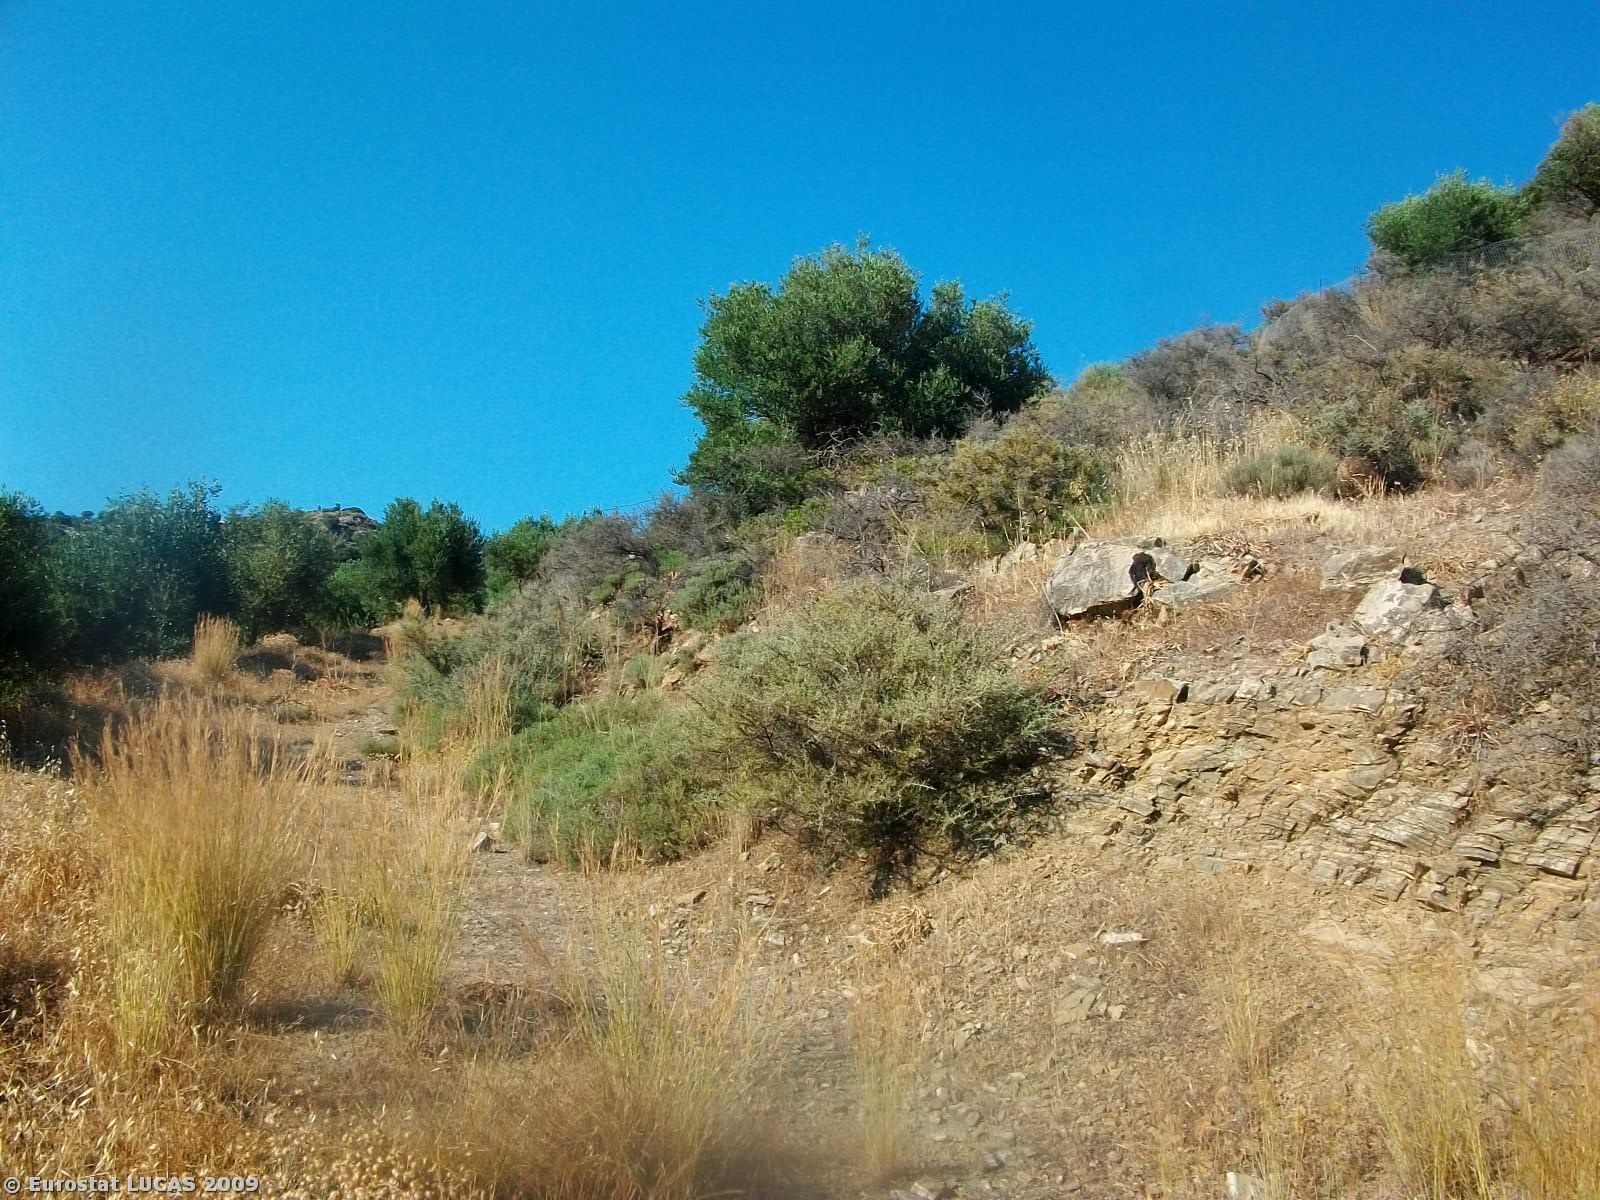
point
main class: Shrubland
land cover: Shrubland with sparse tree cover
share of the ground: > 75 %
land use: Unused
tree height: < 5 m
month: June
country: GR
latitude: 34.9580
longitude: 24.8211
